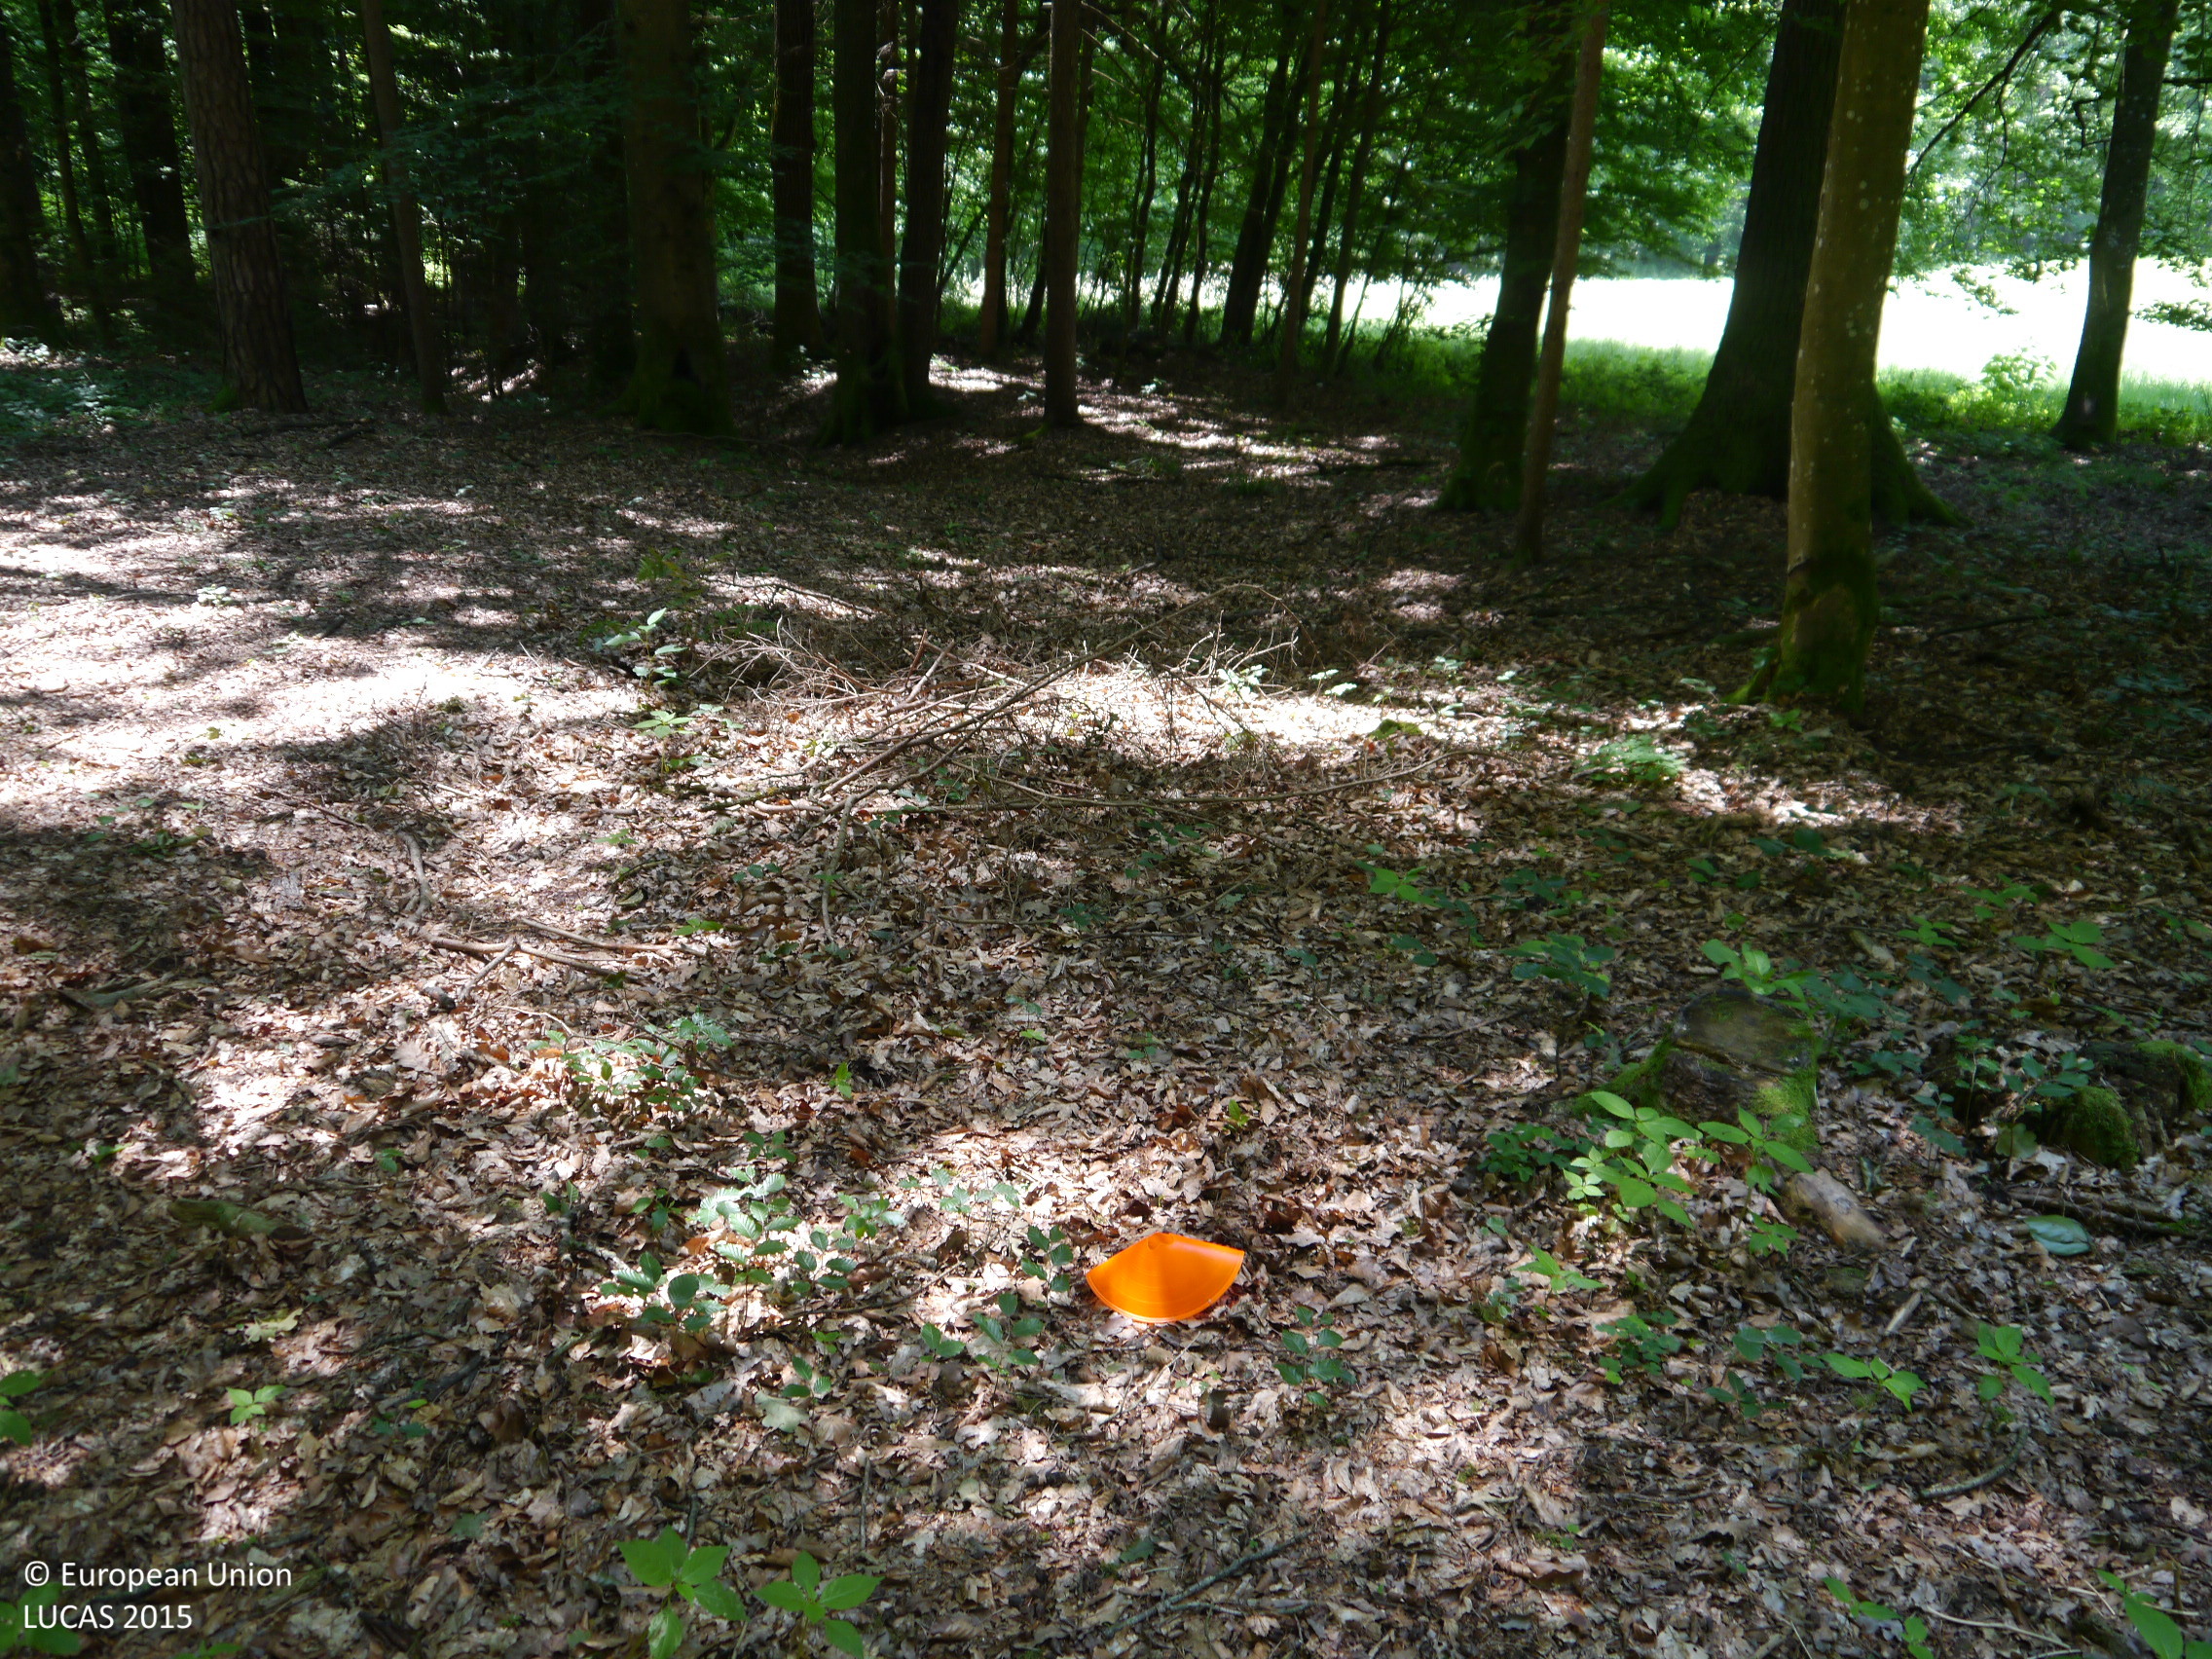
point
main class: Woodland
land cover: Other mixed woodland
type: mountainous beech forest
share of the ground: > 75 %
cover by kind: broadleaved forest trees 70 %, coniferous forest trees 30 %
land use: Forestry
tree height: > 5 m
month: June
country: AT
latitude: 46.9055
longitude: 15.6581
